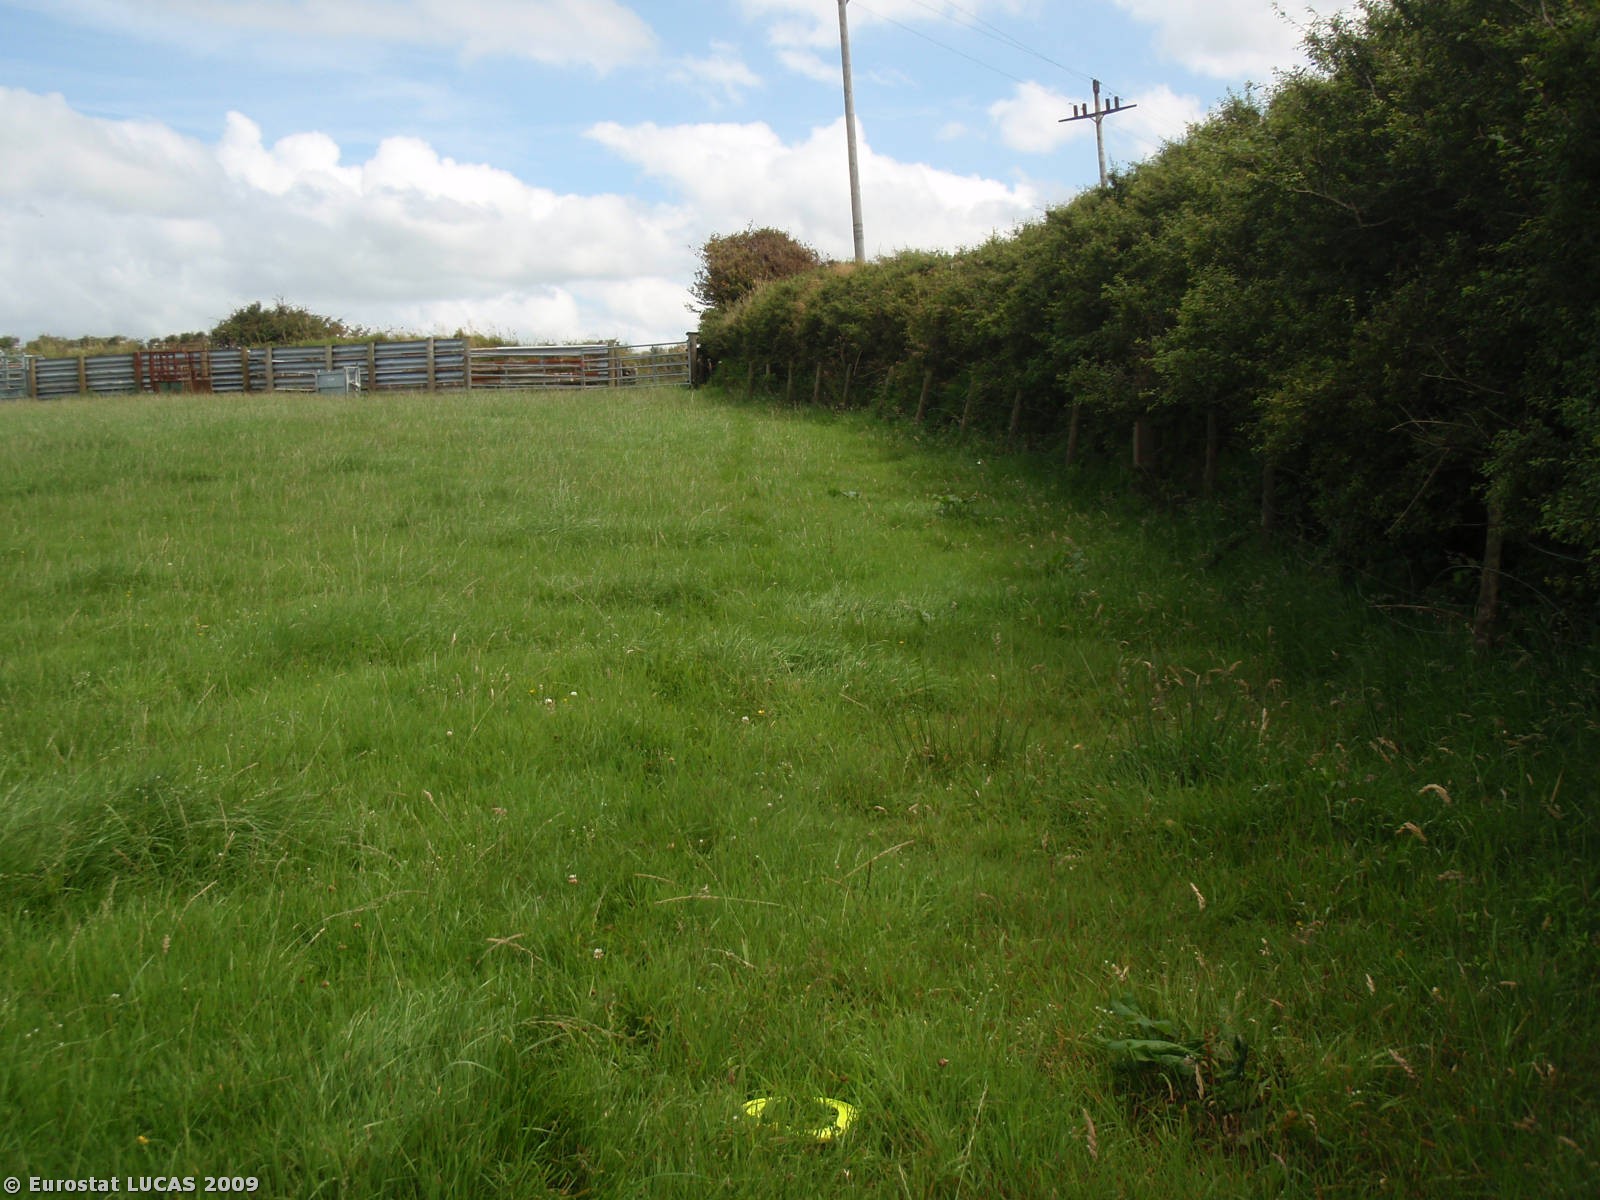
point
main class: Grassland
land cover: Grassland without tree/shrub cover
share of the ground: > 75 %
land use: Agriculture (excluding fallow land and kitchen gardens)
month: August
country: GB
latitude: 50.6379
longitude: -4.6579
